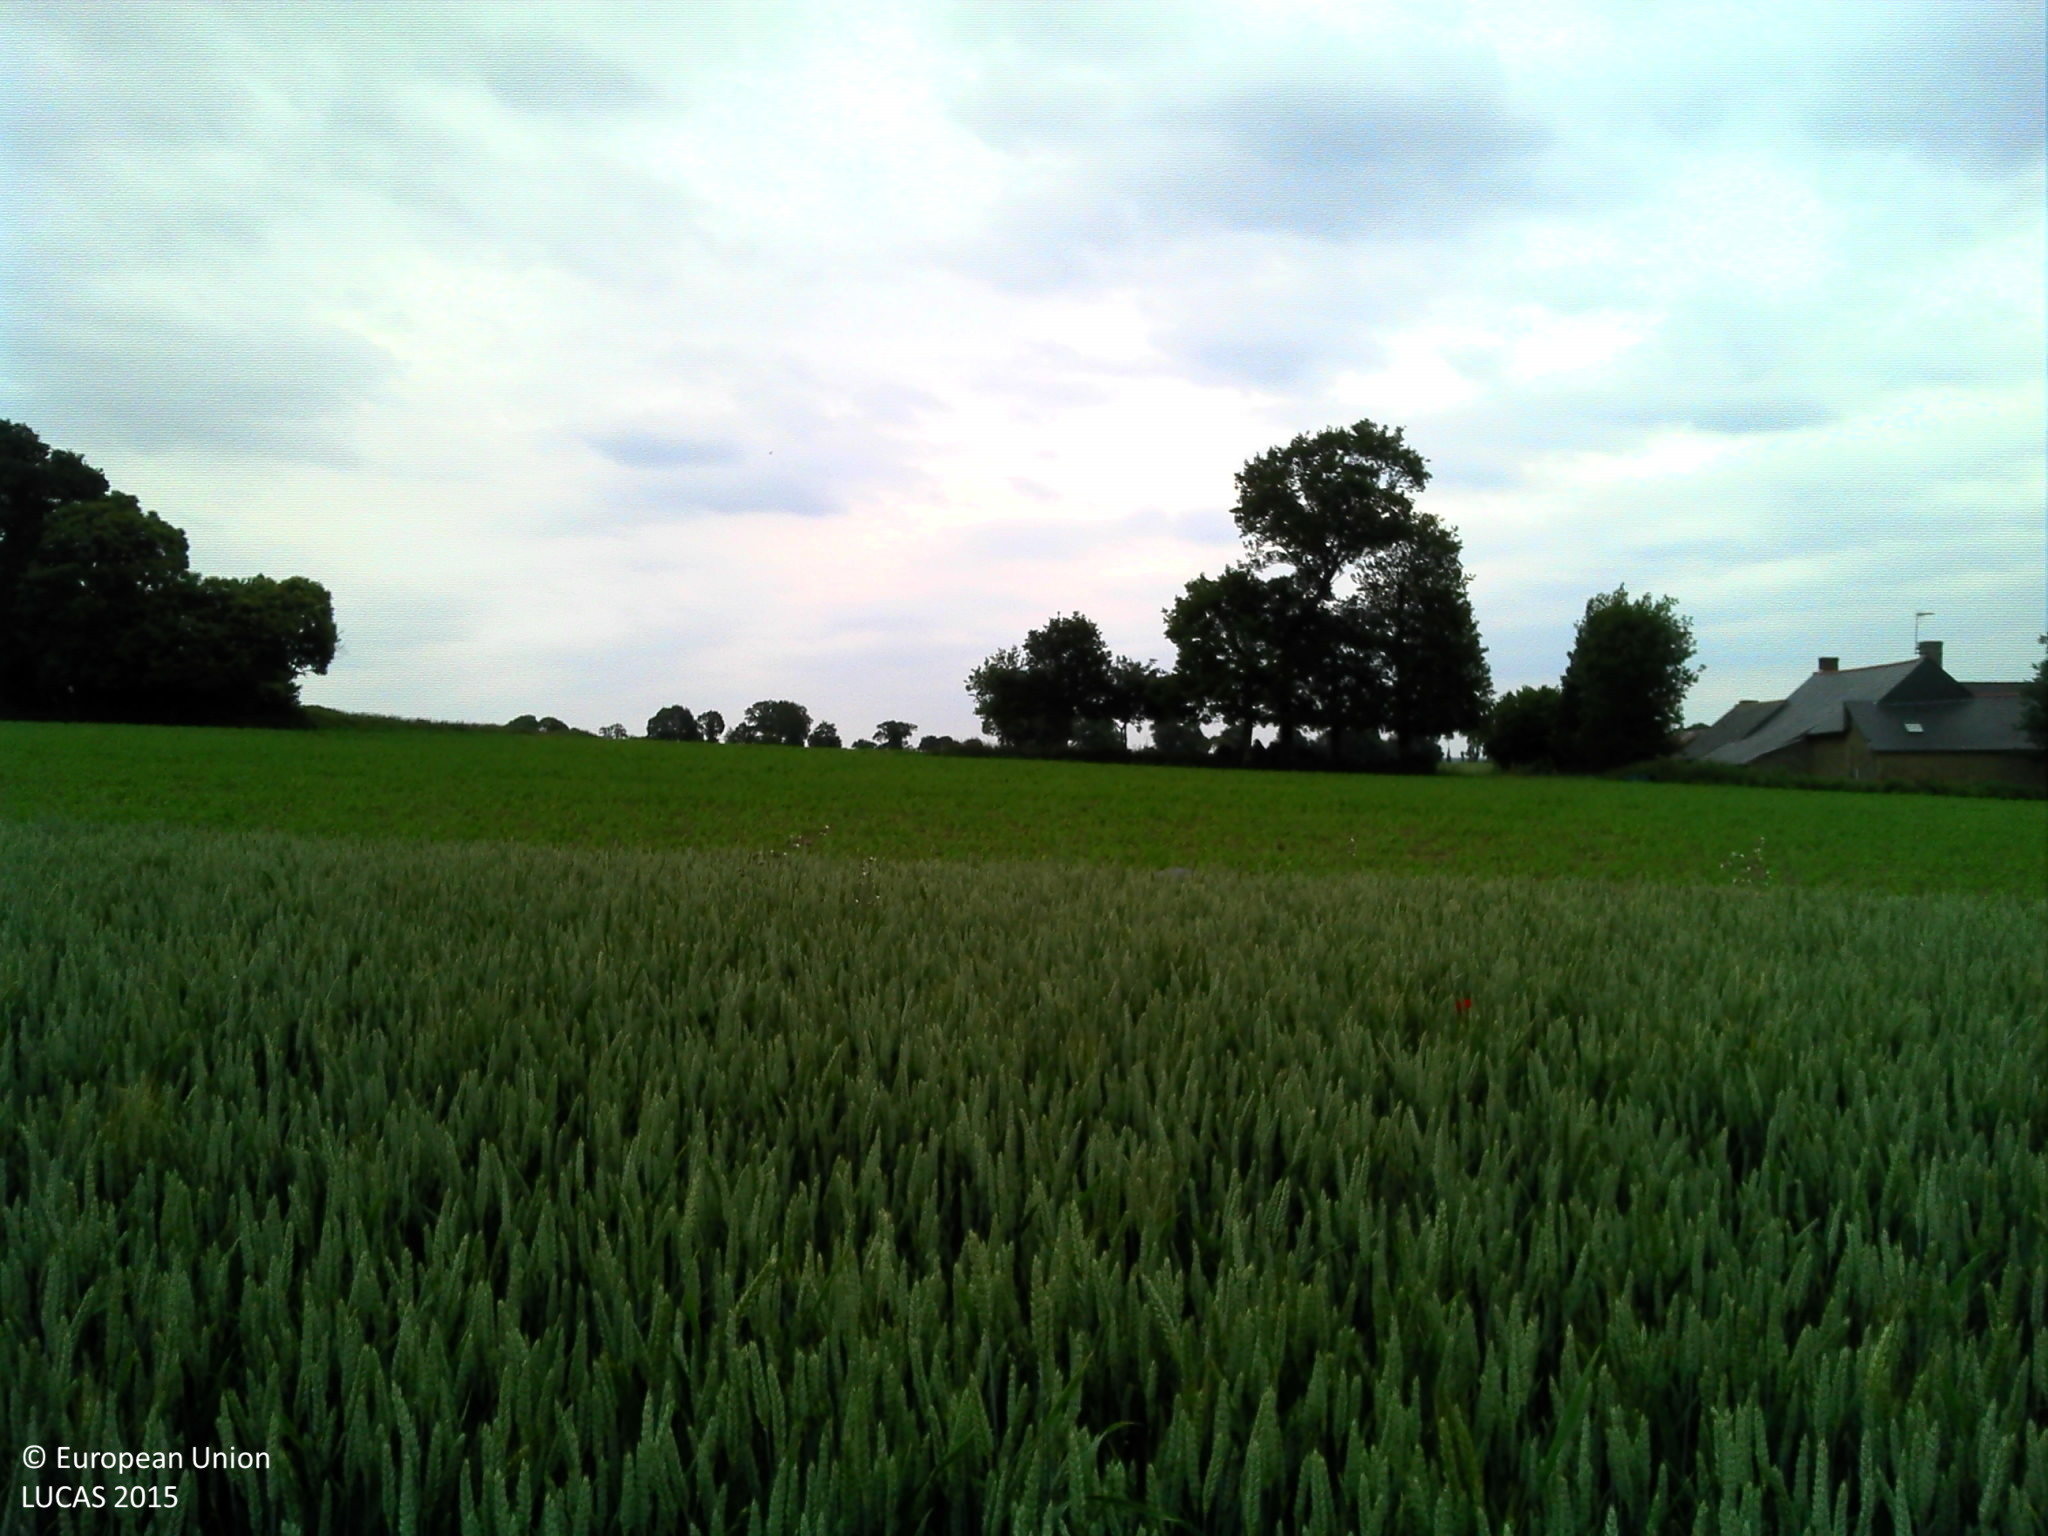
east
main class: Cropland
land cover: Common wheat
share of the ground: > 75 %
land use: Agriculture (excluding fallow land and kitchen gardens)
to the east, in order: Common wheat; Maize; Lines of trees; Fences; Maize; Fences; Tracks; Fences; Grassland without tree/shrub cover
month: June
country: FR
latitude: 48.2023
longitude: -1.6599
